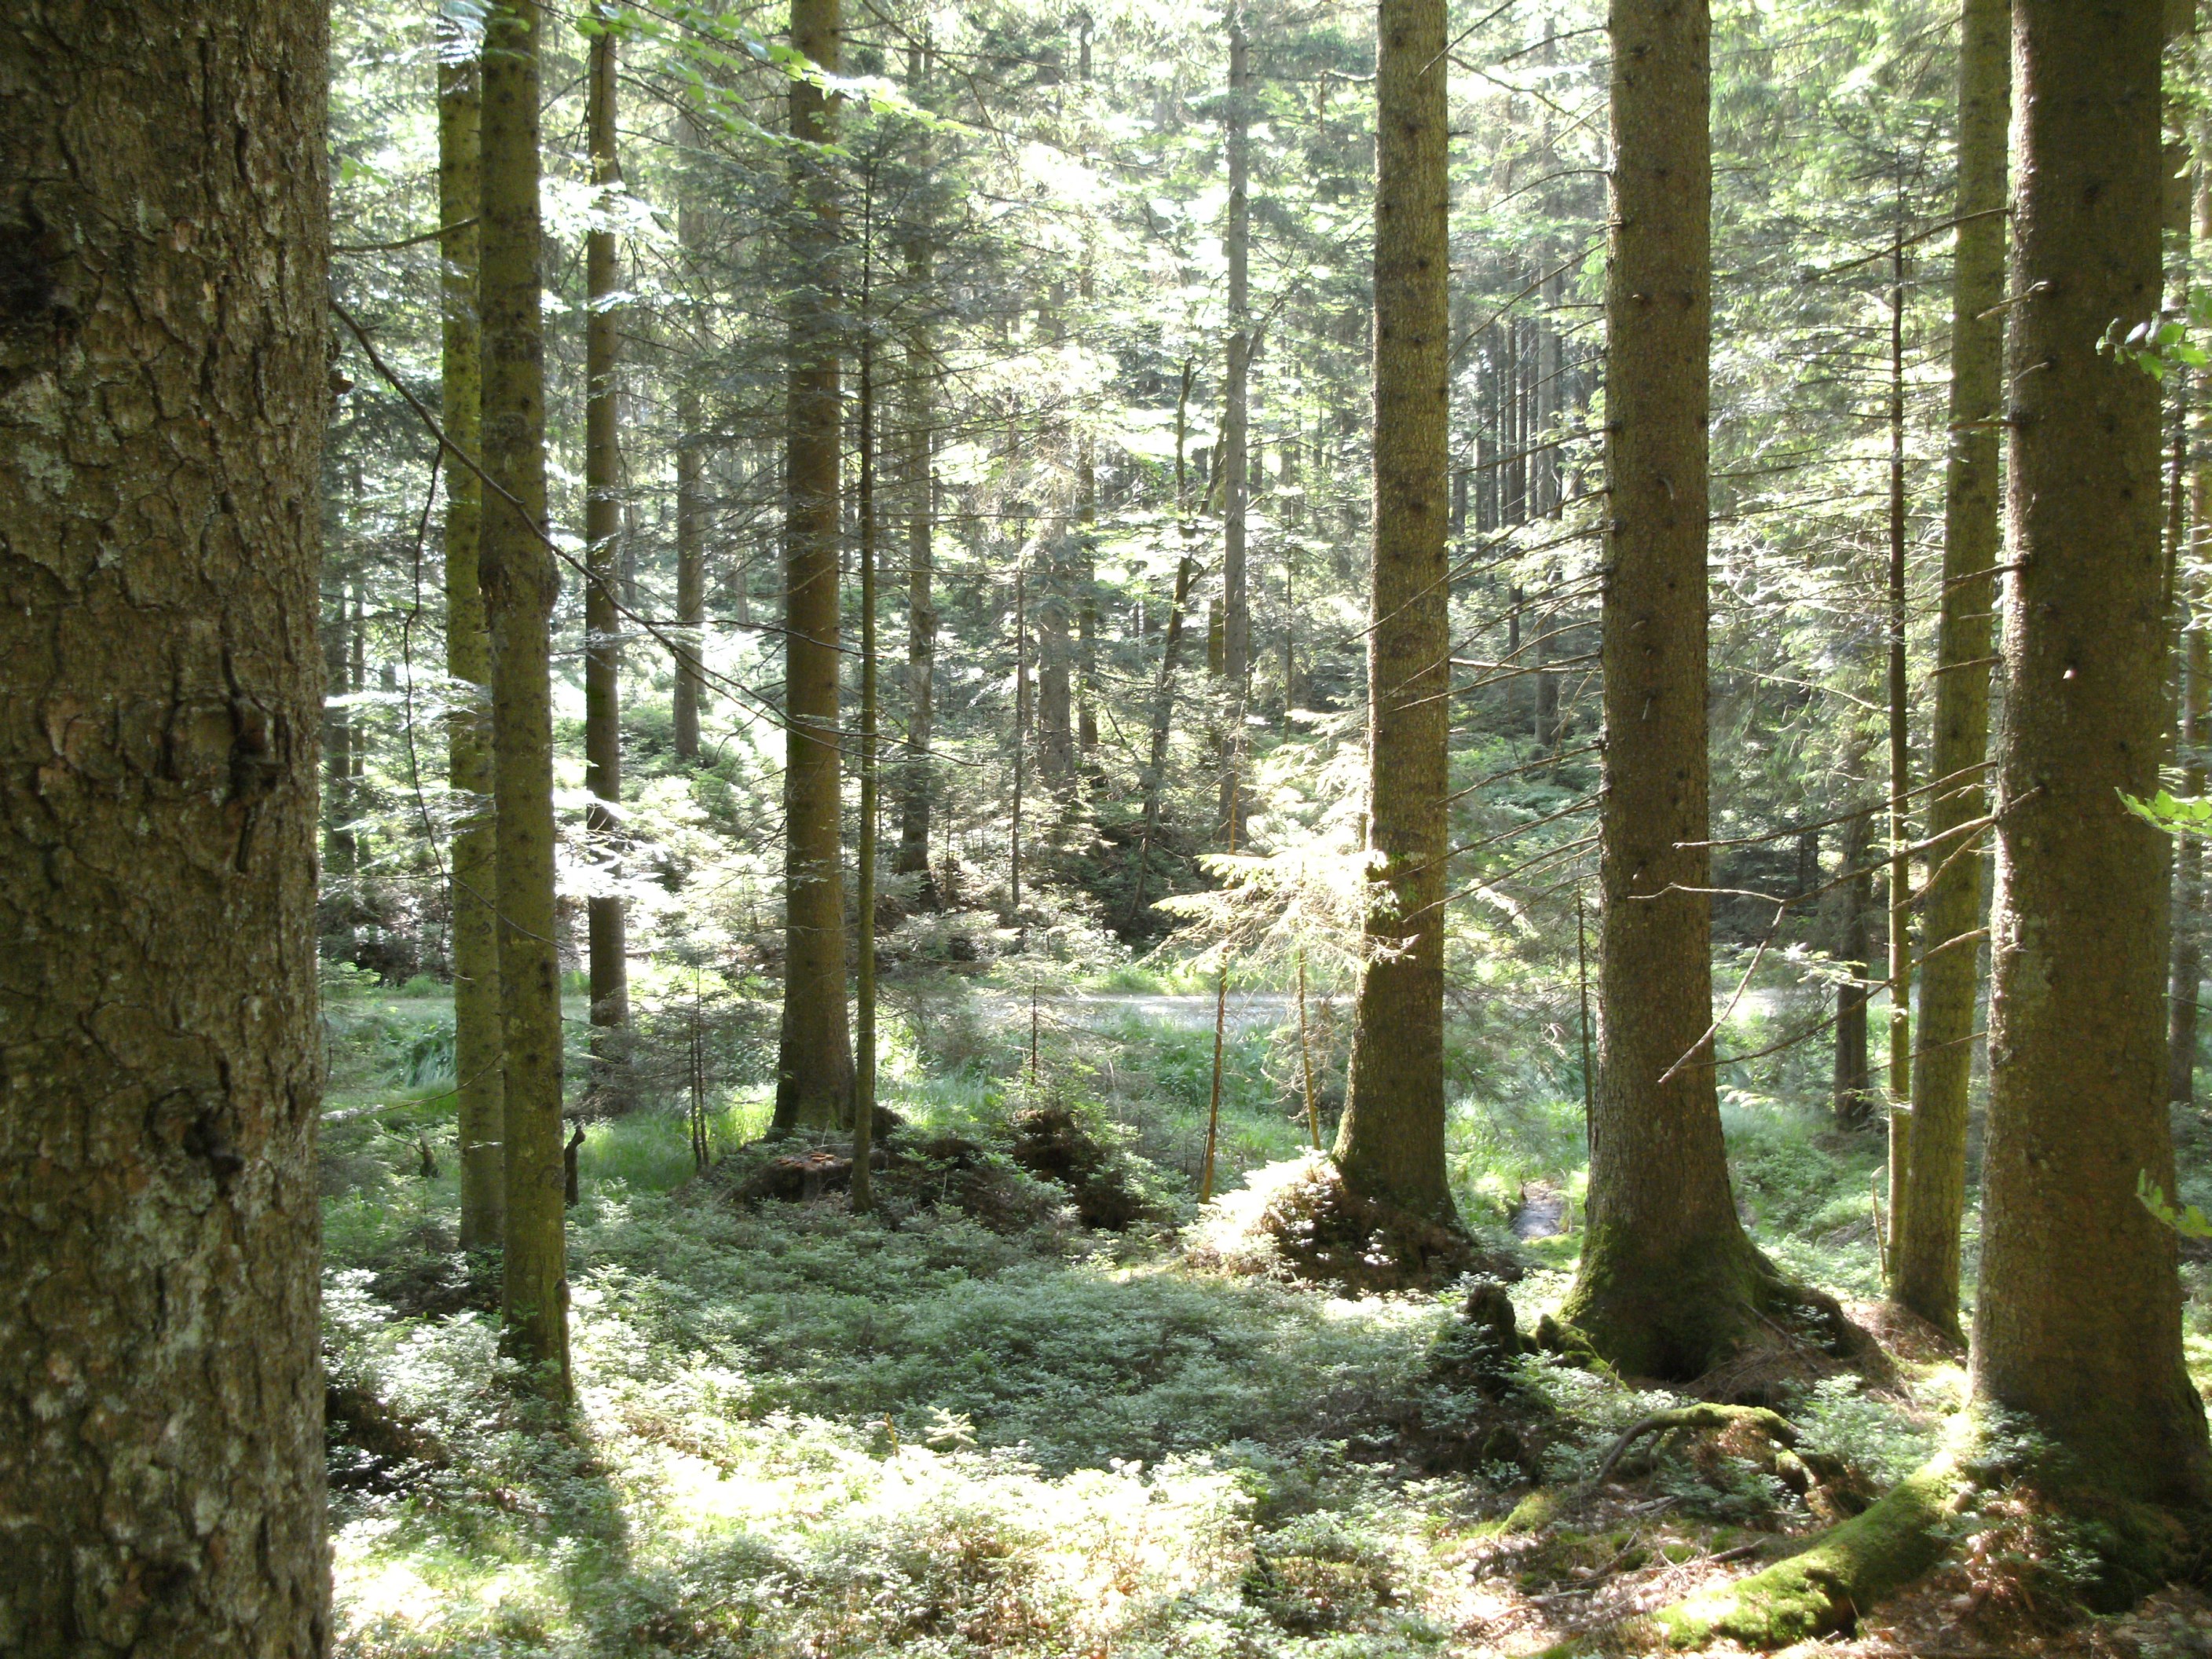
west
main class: Woodland
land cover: Other mixed woodland
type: hemiboreal forest and nemoral coniferous forest and mixed broadleaved-coniferous forest
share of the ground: > 75 %
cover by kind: broadleaved forest trees 55 %, coniferous forest trees 35 %, herbaceous plants 5 %, lichens and mosses 5 %
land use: Forestry
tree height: > 5 m
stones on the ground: < 10 %
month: June
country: AT
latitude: 48.0829
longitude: 13.3416
